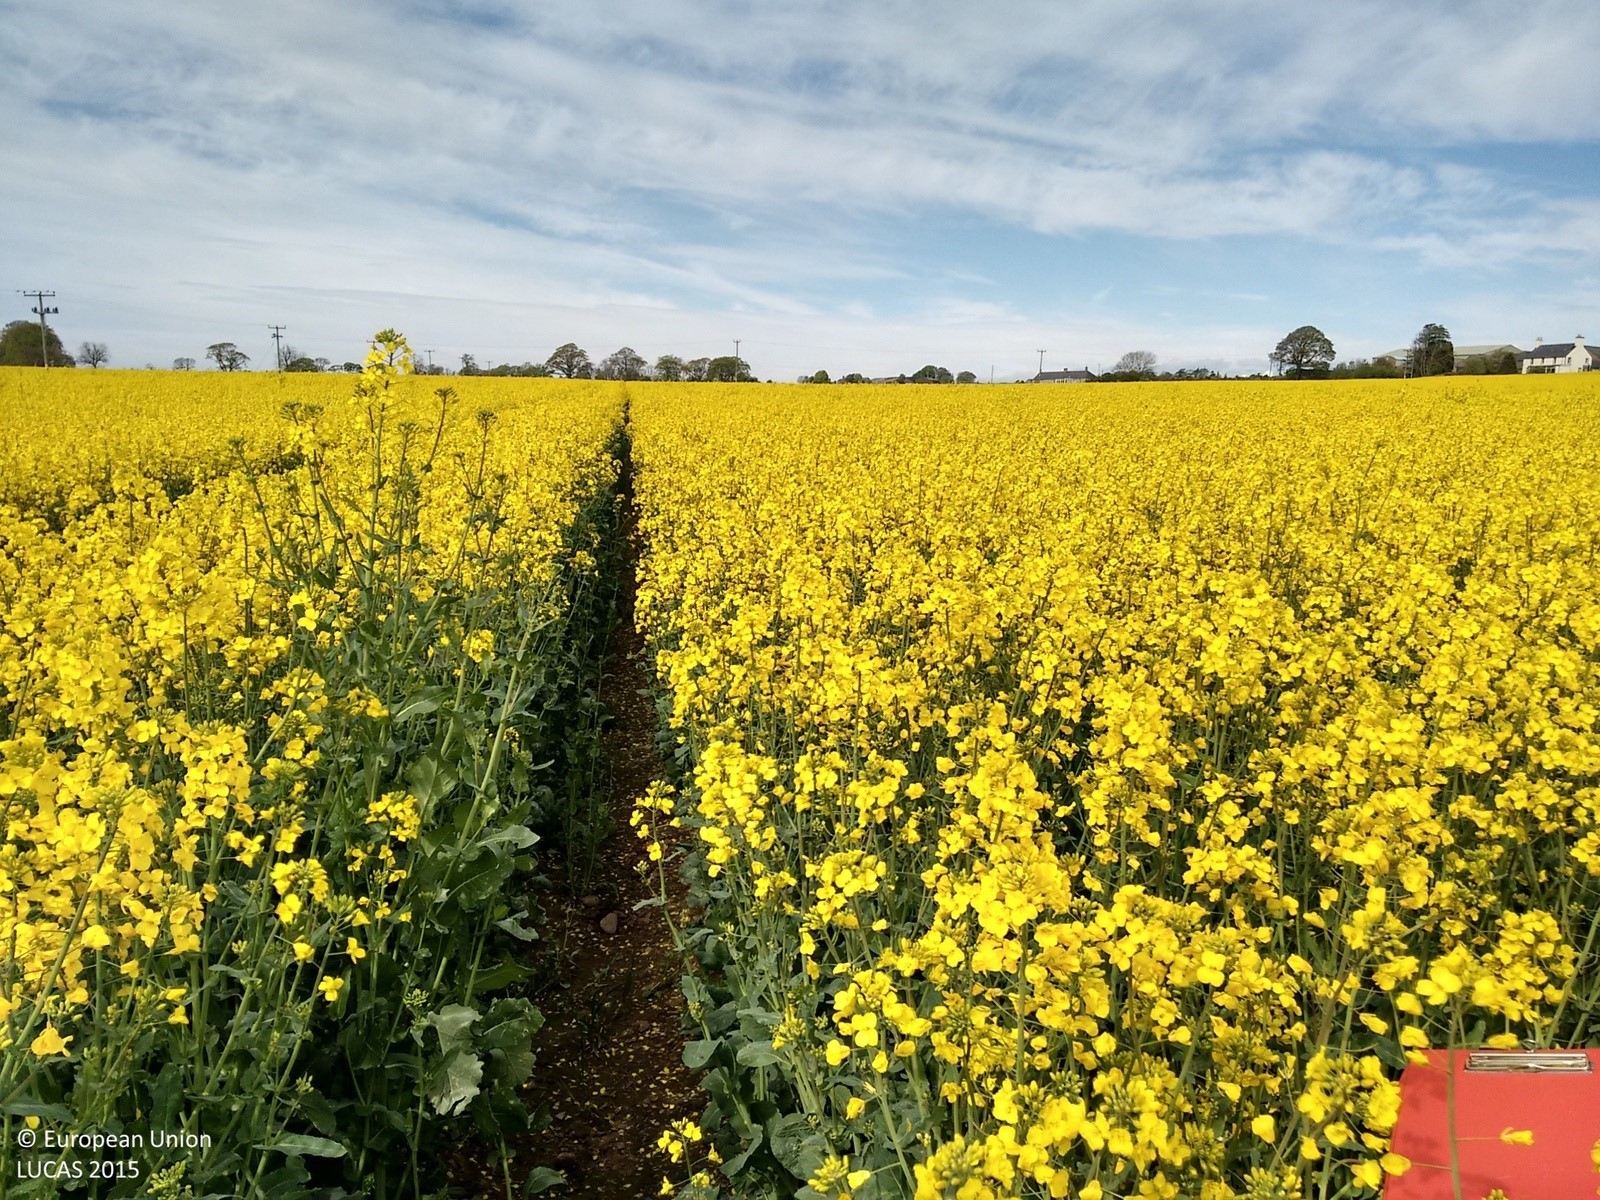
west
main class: Cropland
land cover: Rape and turnip rape
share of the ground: > 75 %
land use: Agriculture (excluding fallow land and kitchen gardens)
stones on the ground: 10 - 25 %
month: May
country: GB
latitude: 56.7066
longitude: -2.6527
